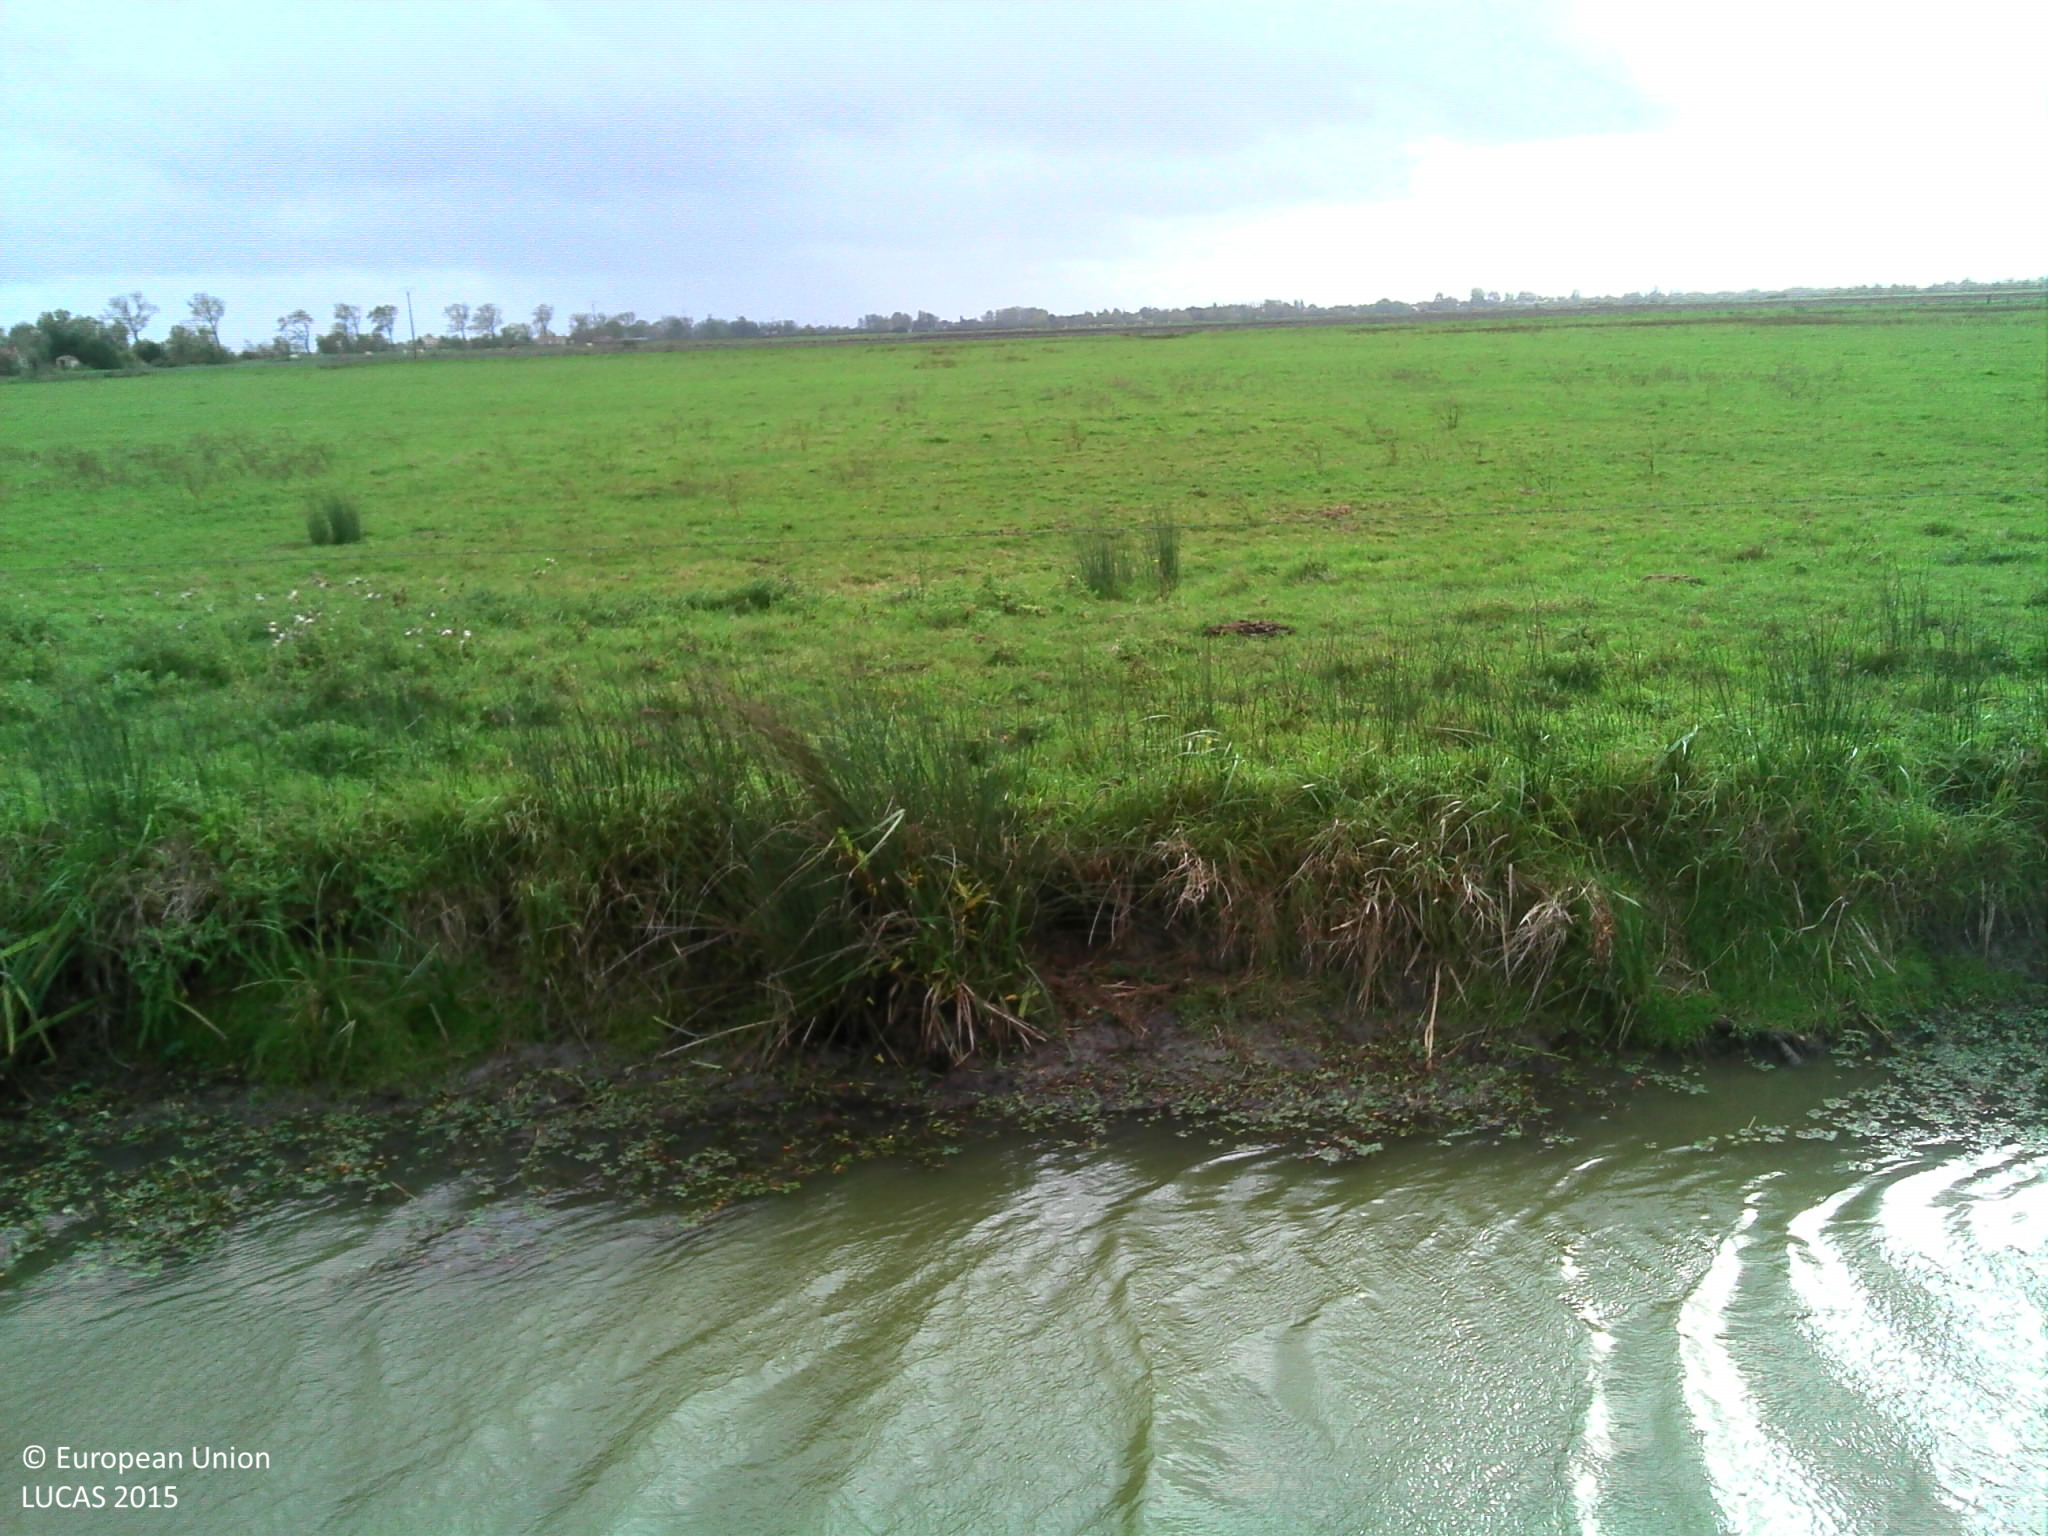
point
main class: Grassland
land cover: Grassland without tree/shrub cover
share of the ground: > 75 %
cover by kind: herbaceous plants 100 %
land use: Agriculture (excluding fallow land and kitchen gardens)
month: October
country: FR
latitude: 46.3949
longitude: -1.0473
